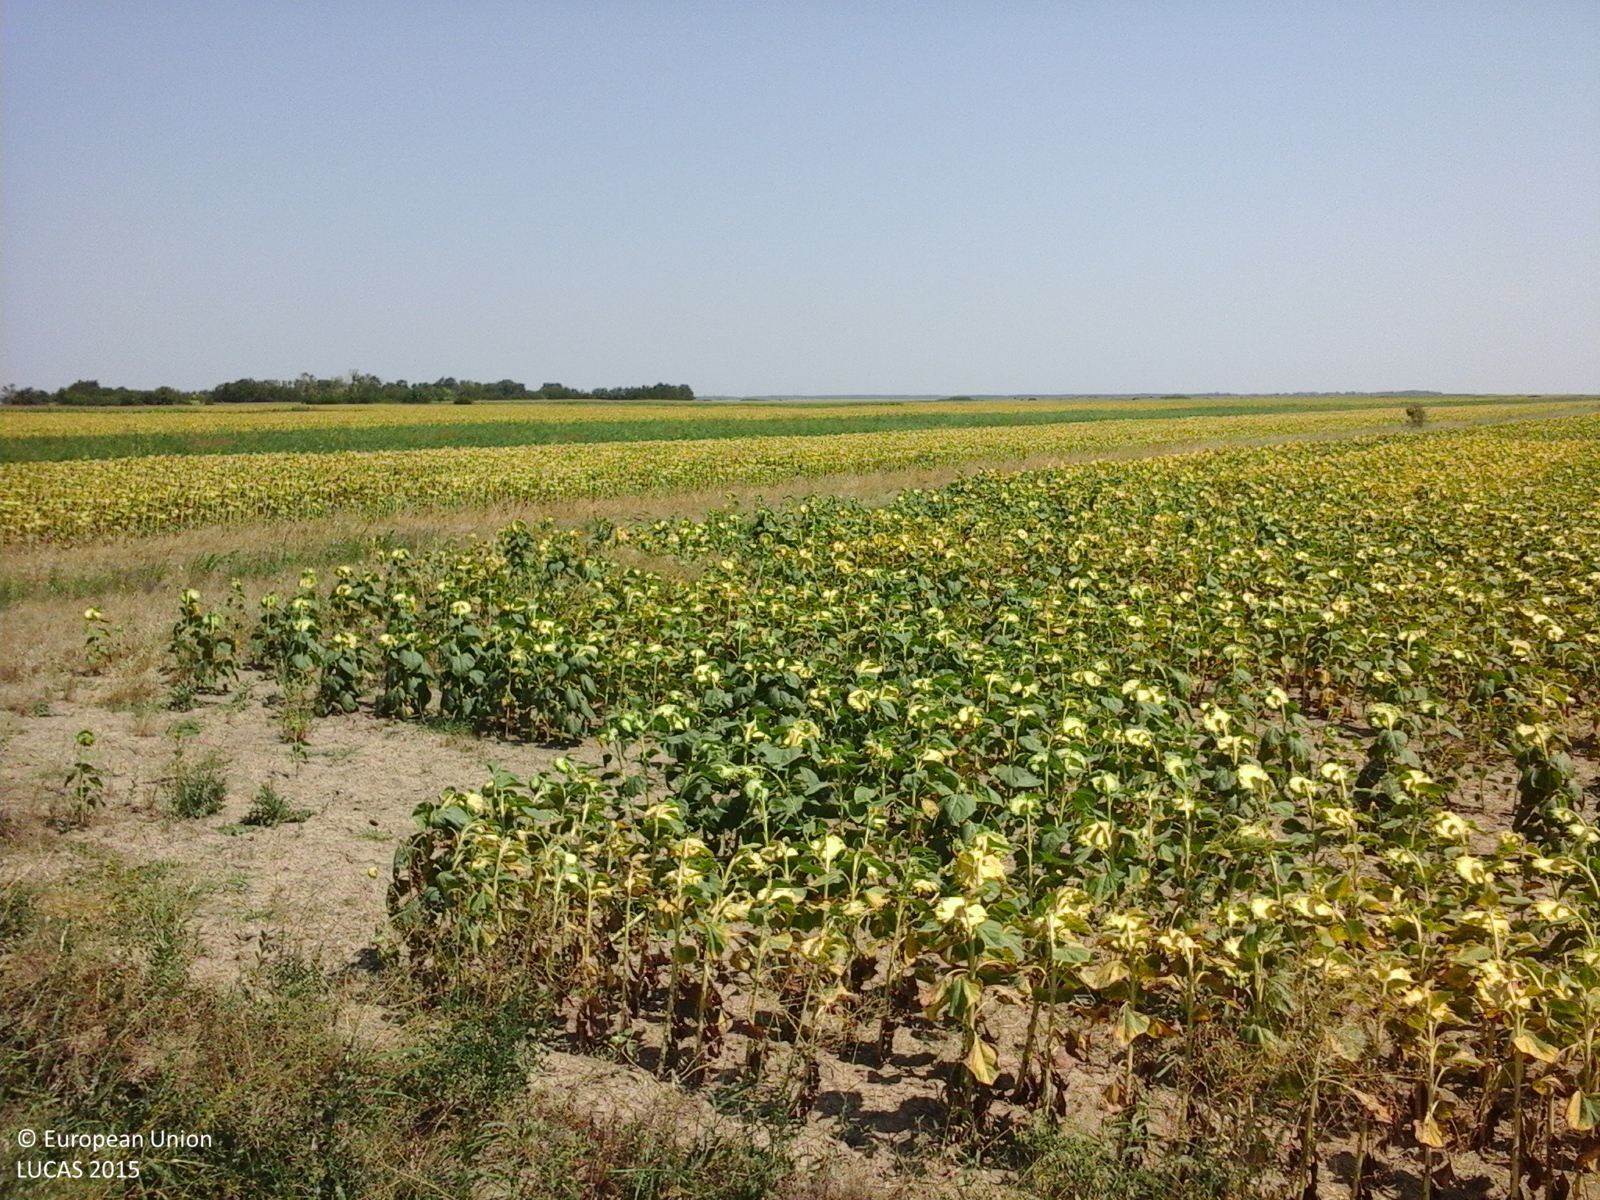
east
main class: Cropland
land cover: Sunflower
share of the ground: > 75 %
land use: Agriculture (excluding fallow land and kitchen gardens)
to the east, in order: Sunflower; Grass margins; Tracks; Grass margins; Ditches and canals; Grass margins; Tracks; Grass margins; Sunflower
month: August
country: RO
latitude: 45.4940
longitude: 27.5450
